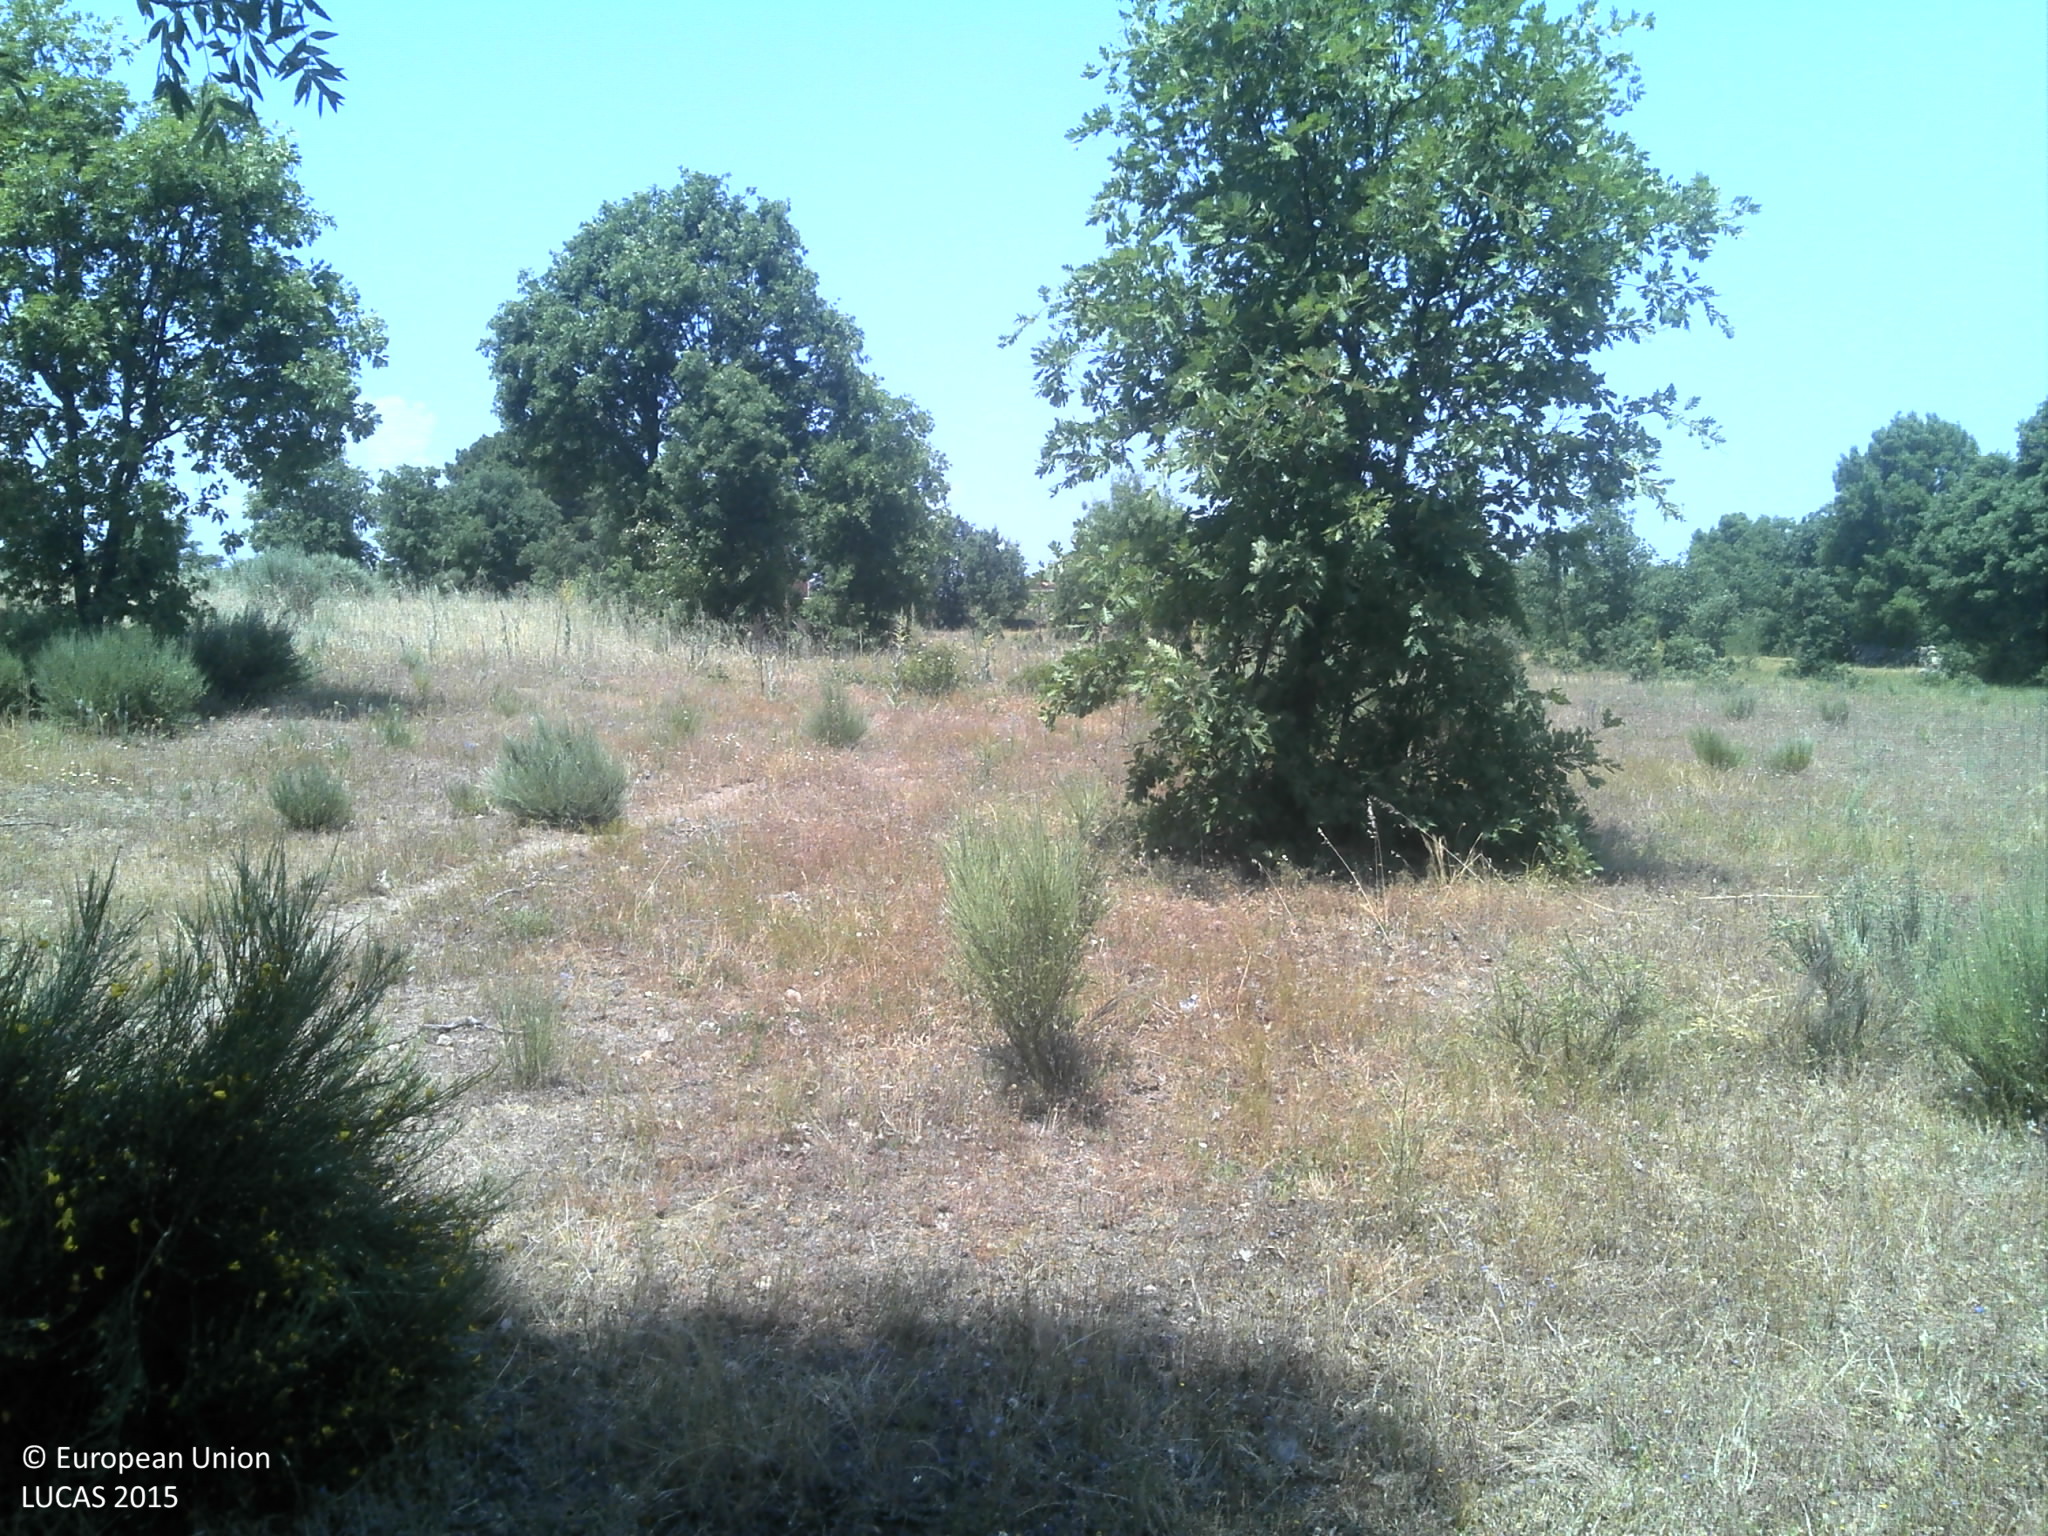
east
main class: Grassland
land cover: Grassland with sparse tree/shrub cover
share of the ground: 50 - 75 %
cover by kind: herbaceous plants 75 %, unconsolidated bare surface 20 %, broadleaved forest trees 5 %
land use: Agriculture (excluding fallow land and kitchen gardens)
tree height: > 5 m
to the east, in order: Grassland with sparse tree/shrub cover; Dry stone walls; Fences; Lines of trees; Tracks; Dry stone walls; Lines of trees; Grassland with sparse tree/shrub cover; Broadleaved woodland; Dry stone walls; Fences; Rocks and stones; Dry stone walls; Fences; Broadleaved woodland; Dry stone walls; Grassland without tree/shrub cover; Dry stone walls; Fences; Grassland without tree/shrub cover; Dry stone walls; Lines of trees; Grassland without tree/shrub cover; Dry stone walls; Tracks; Dry stone walls; Grassland with sparse tree/shrub cover
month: June
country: PT
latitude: 40.3726
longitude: -6.8046
